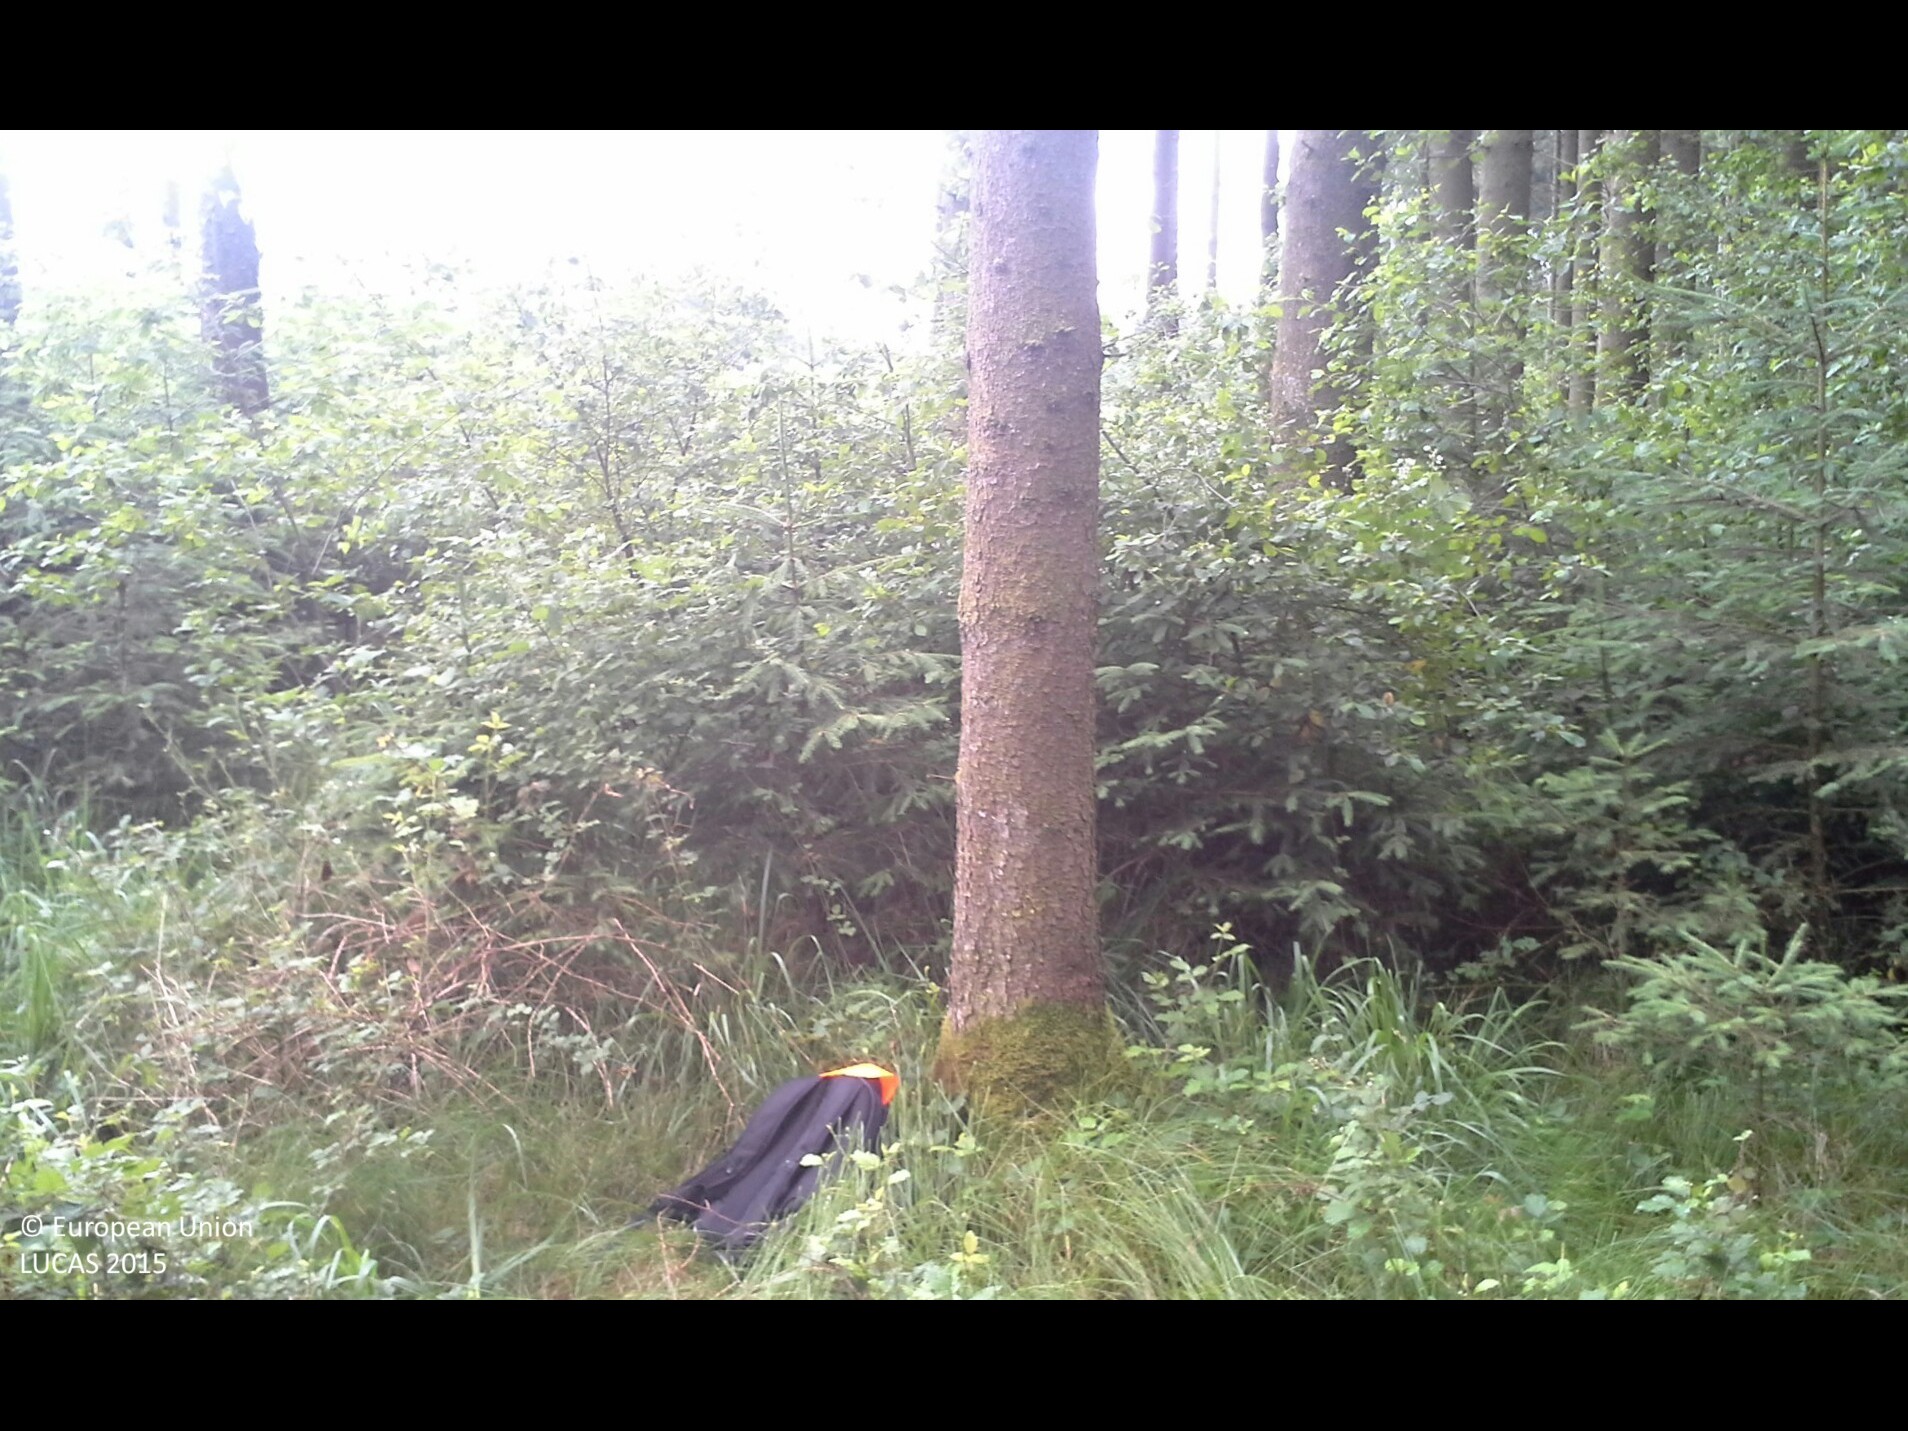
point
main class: Woodland
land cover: Spruce dominated mixed woodland
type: hemiboreal forest and nemoral coniferous forest and mixed broadleaved-coniferous forest
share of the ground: > 75 %
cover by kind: coniferous forest trees 60 %, broadleaved forest trees 25 %, herbaceous plants 10 %, shrubs 5 %
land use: Forestry
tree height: > 5 m
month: June
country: AT
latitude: 48.0924
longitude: 14.5787
